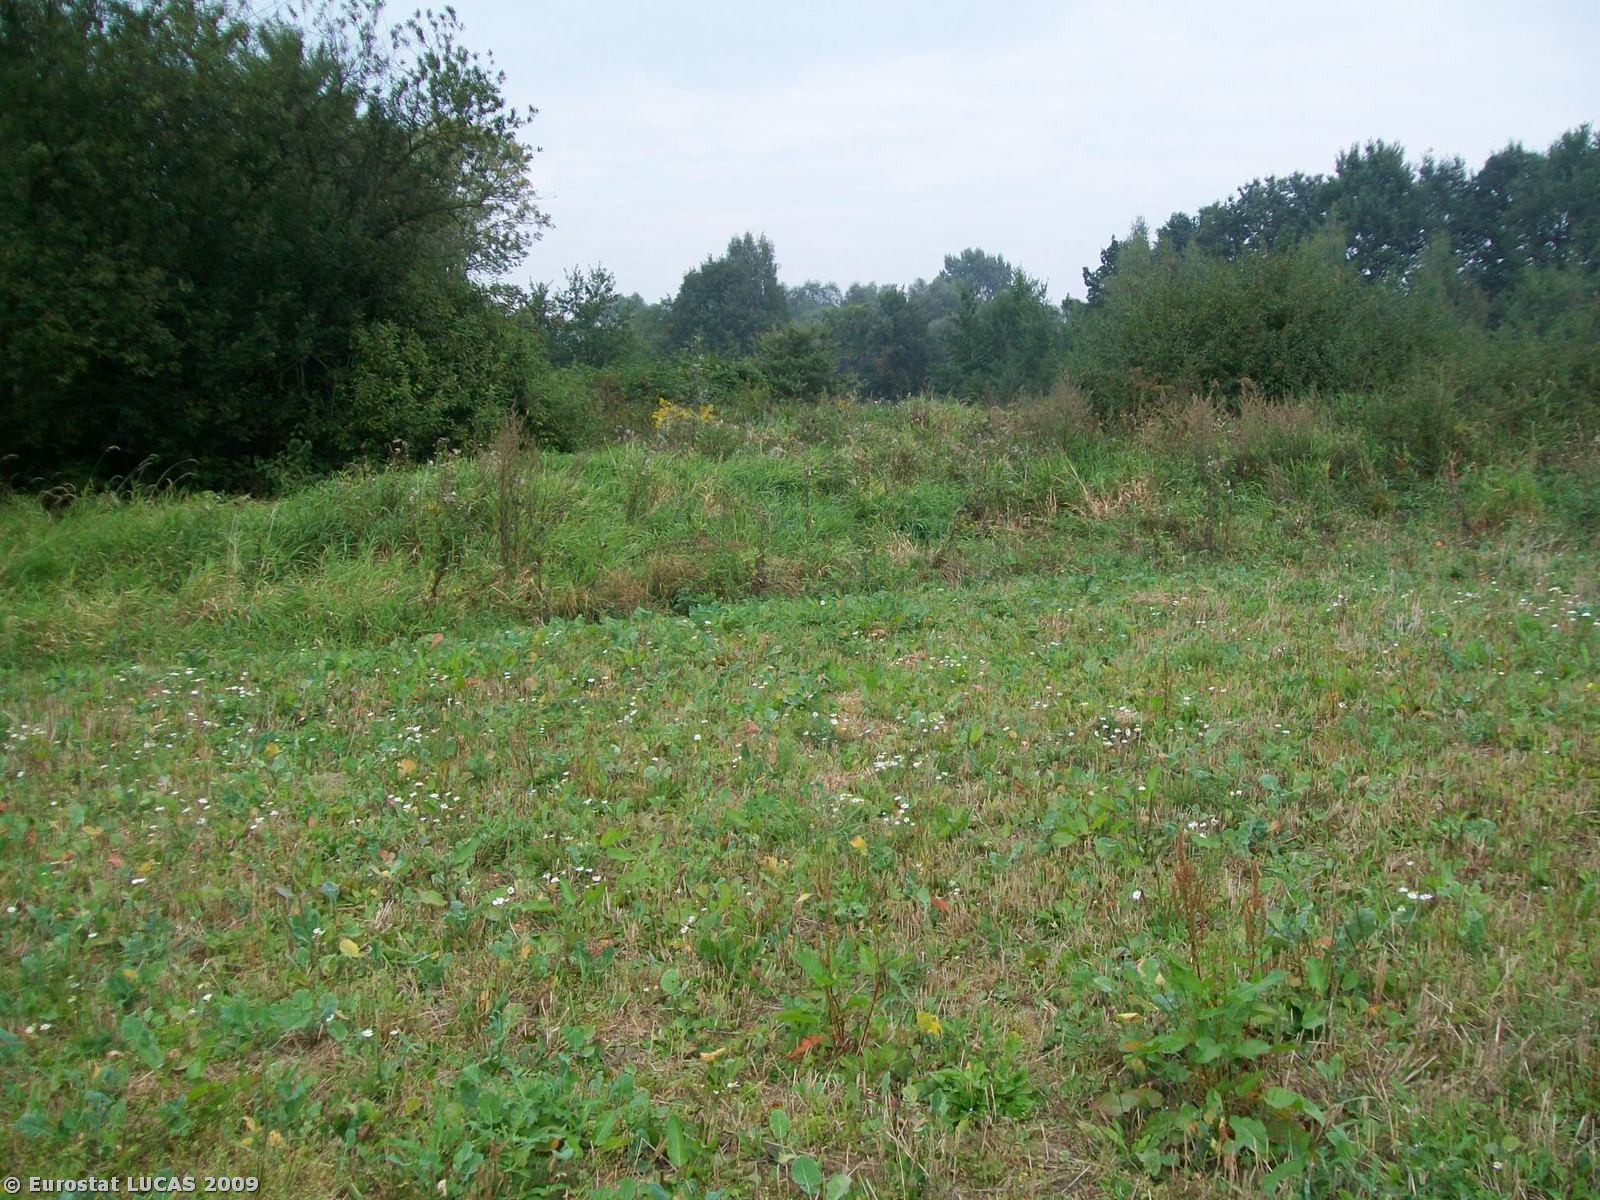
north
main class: Cropland
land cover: Barley
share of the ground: < 10 %
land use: Agriculture (excluding fallow land and kitchen gardens)
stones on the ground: < 10 %
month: September
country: PL
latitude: 50.4382
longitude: 17.2908
